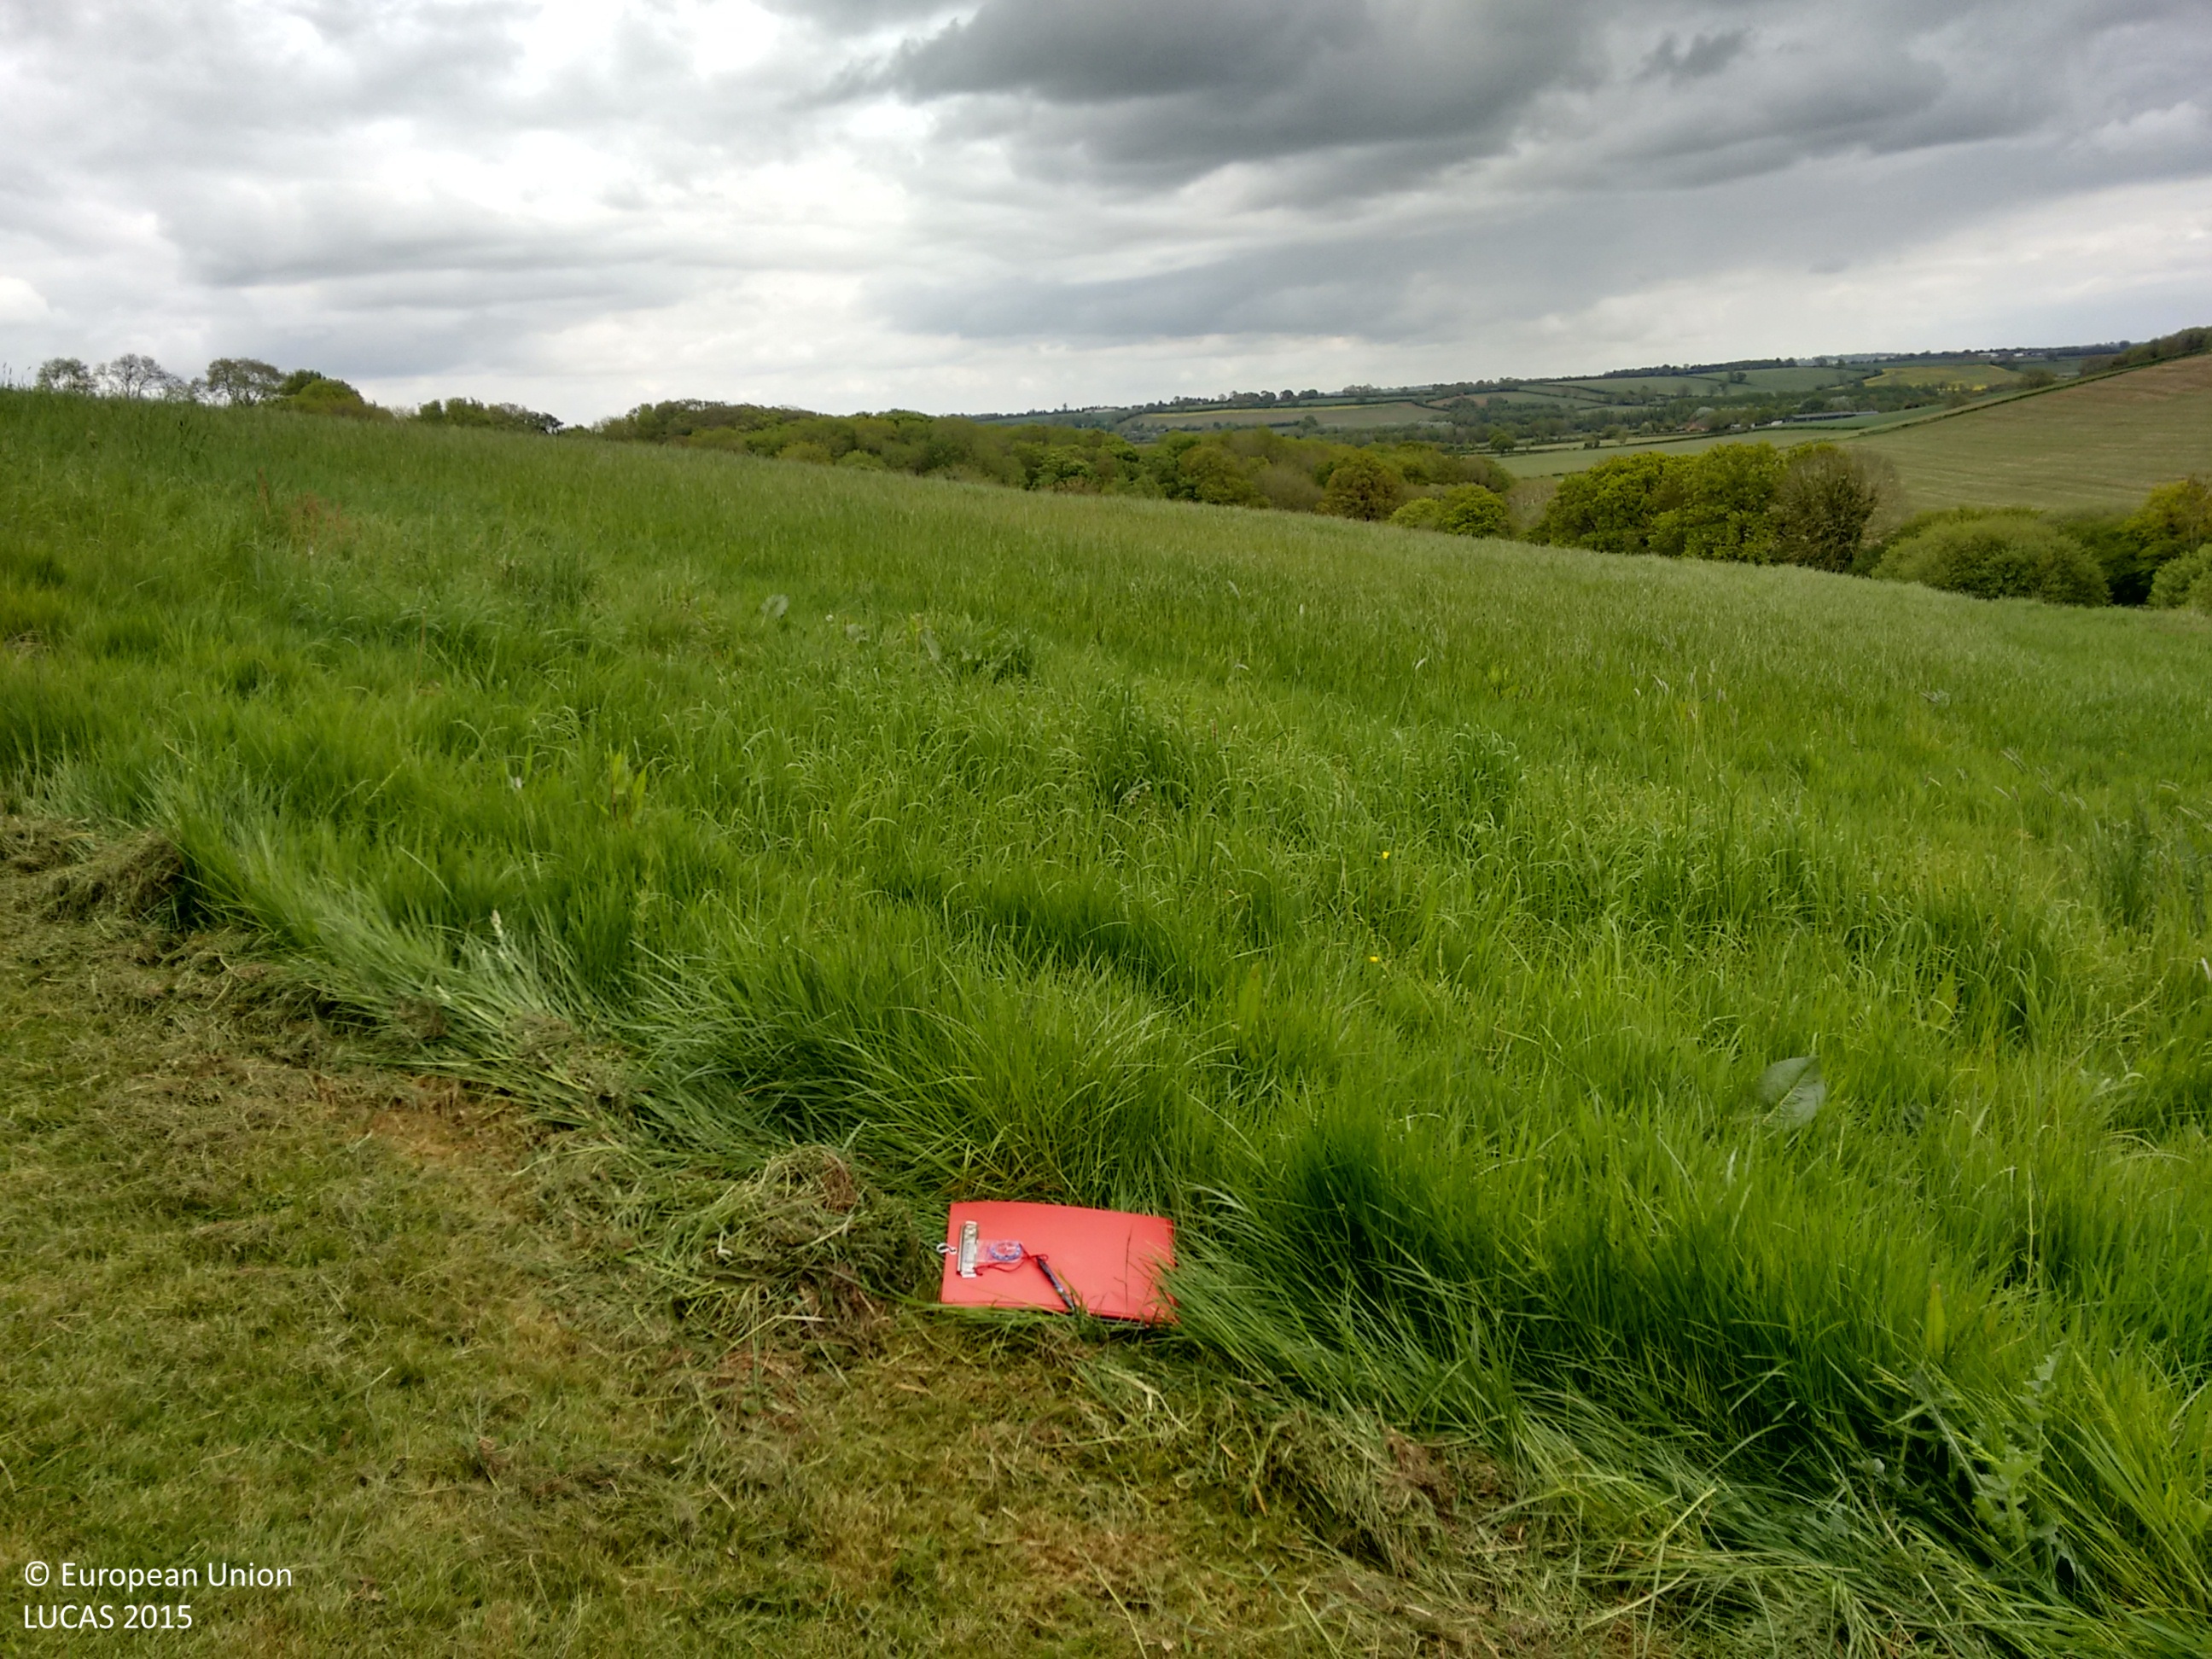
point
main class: Grassland
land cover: Grassland without tree/shrub cover
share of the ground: > 75 %
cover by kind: herbaceous plants 100 %
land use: Agriculture (excluding fallow land and kitchen gardens)
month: May
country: GB
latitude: 52.1171
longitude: -1.3970
